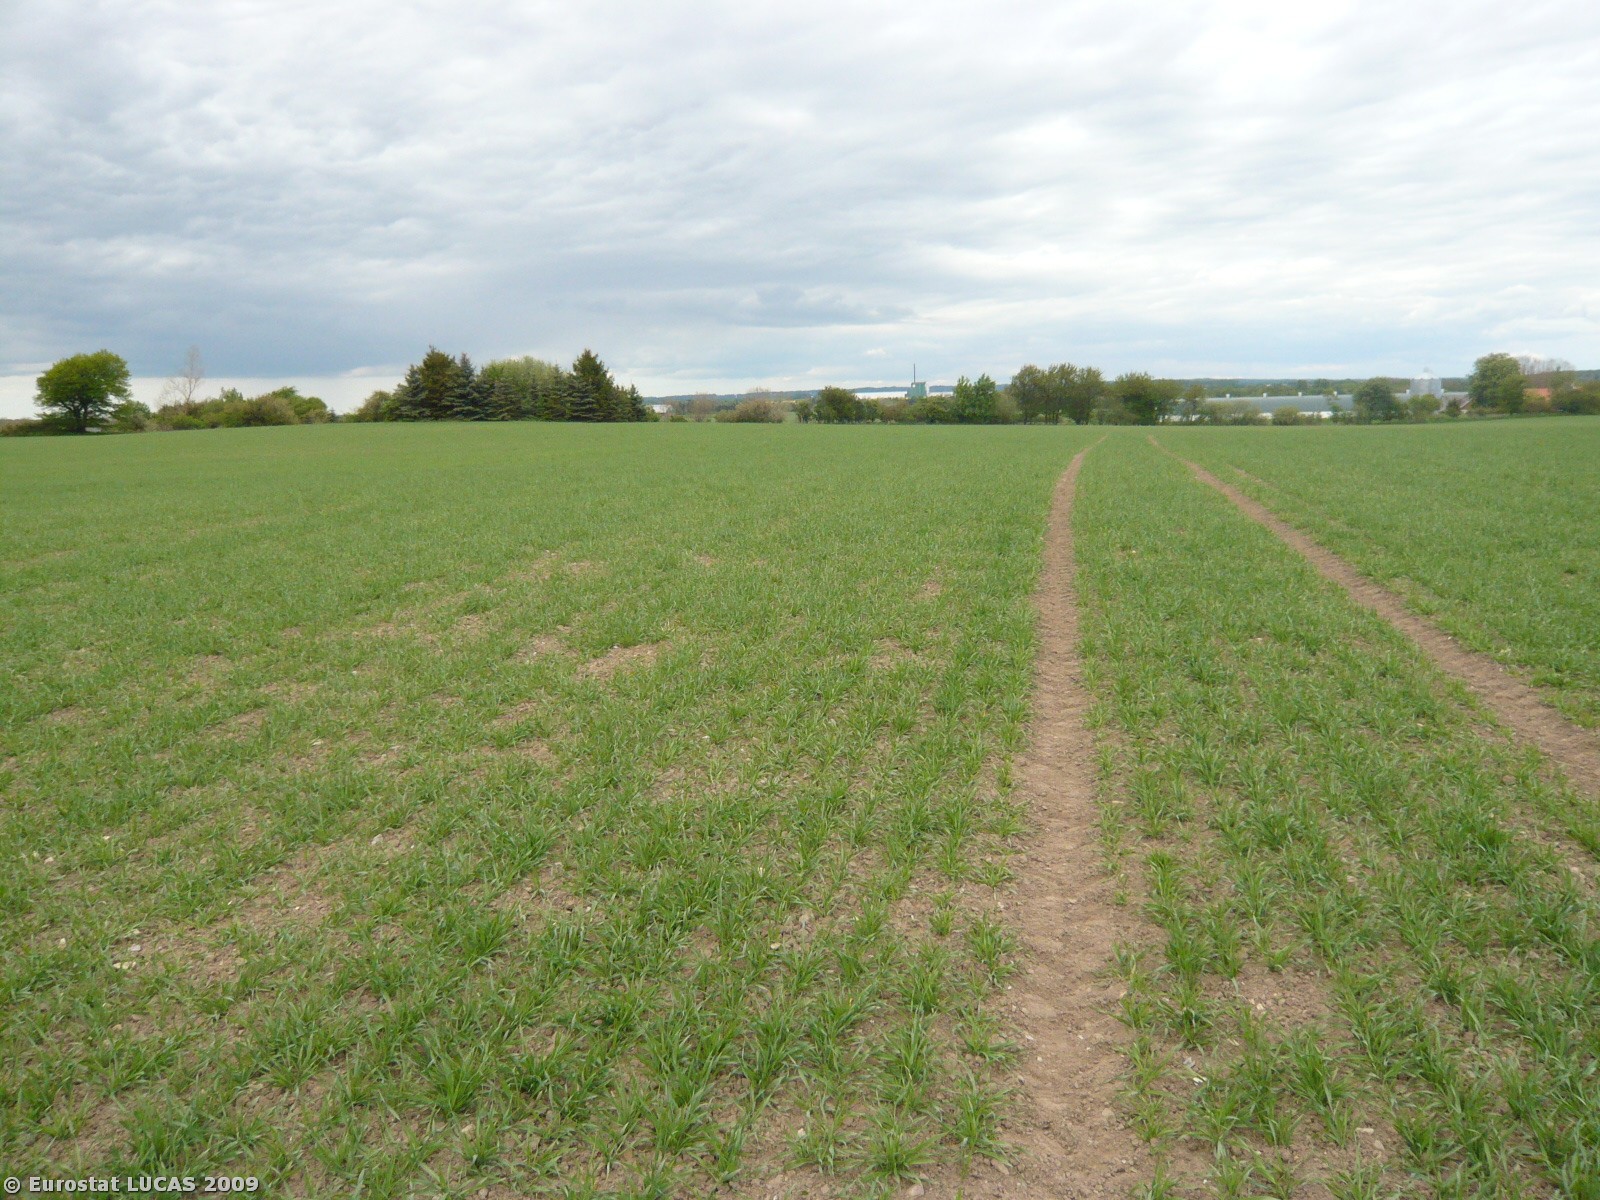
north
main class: Cropland
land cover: Common wheat
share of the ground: 25 - 50 %
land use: Agriculture (excluding fallow land and kitchen gardens)
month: May
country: DK
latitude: 55.0940
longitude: 11.9573
